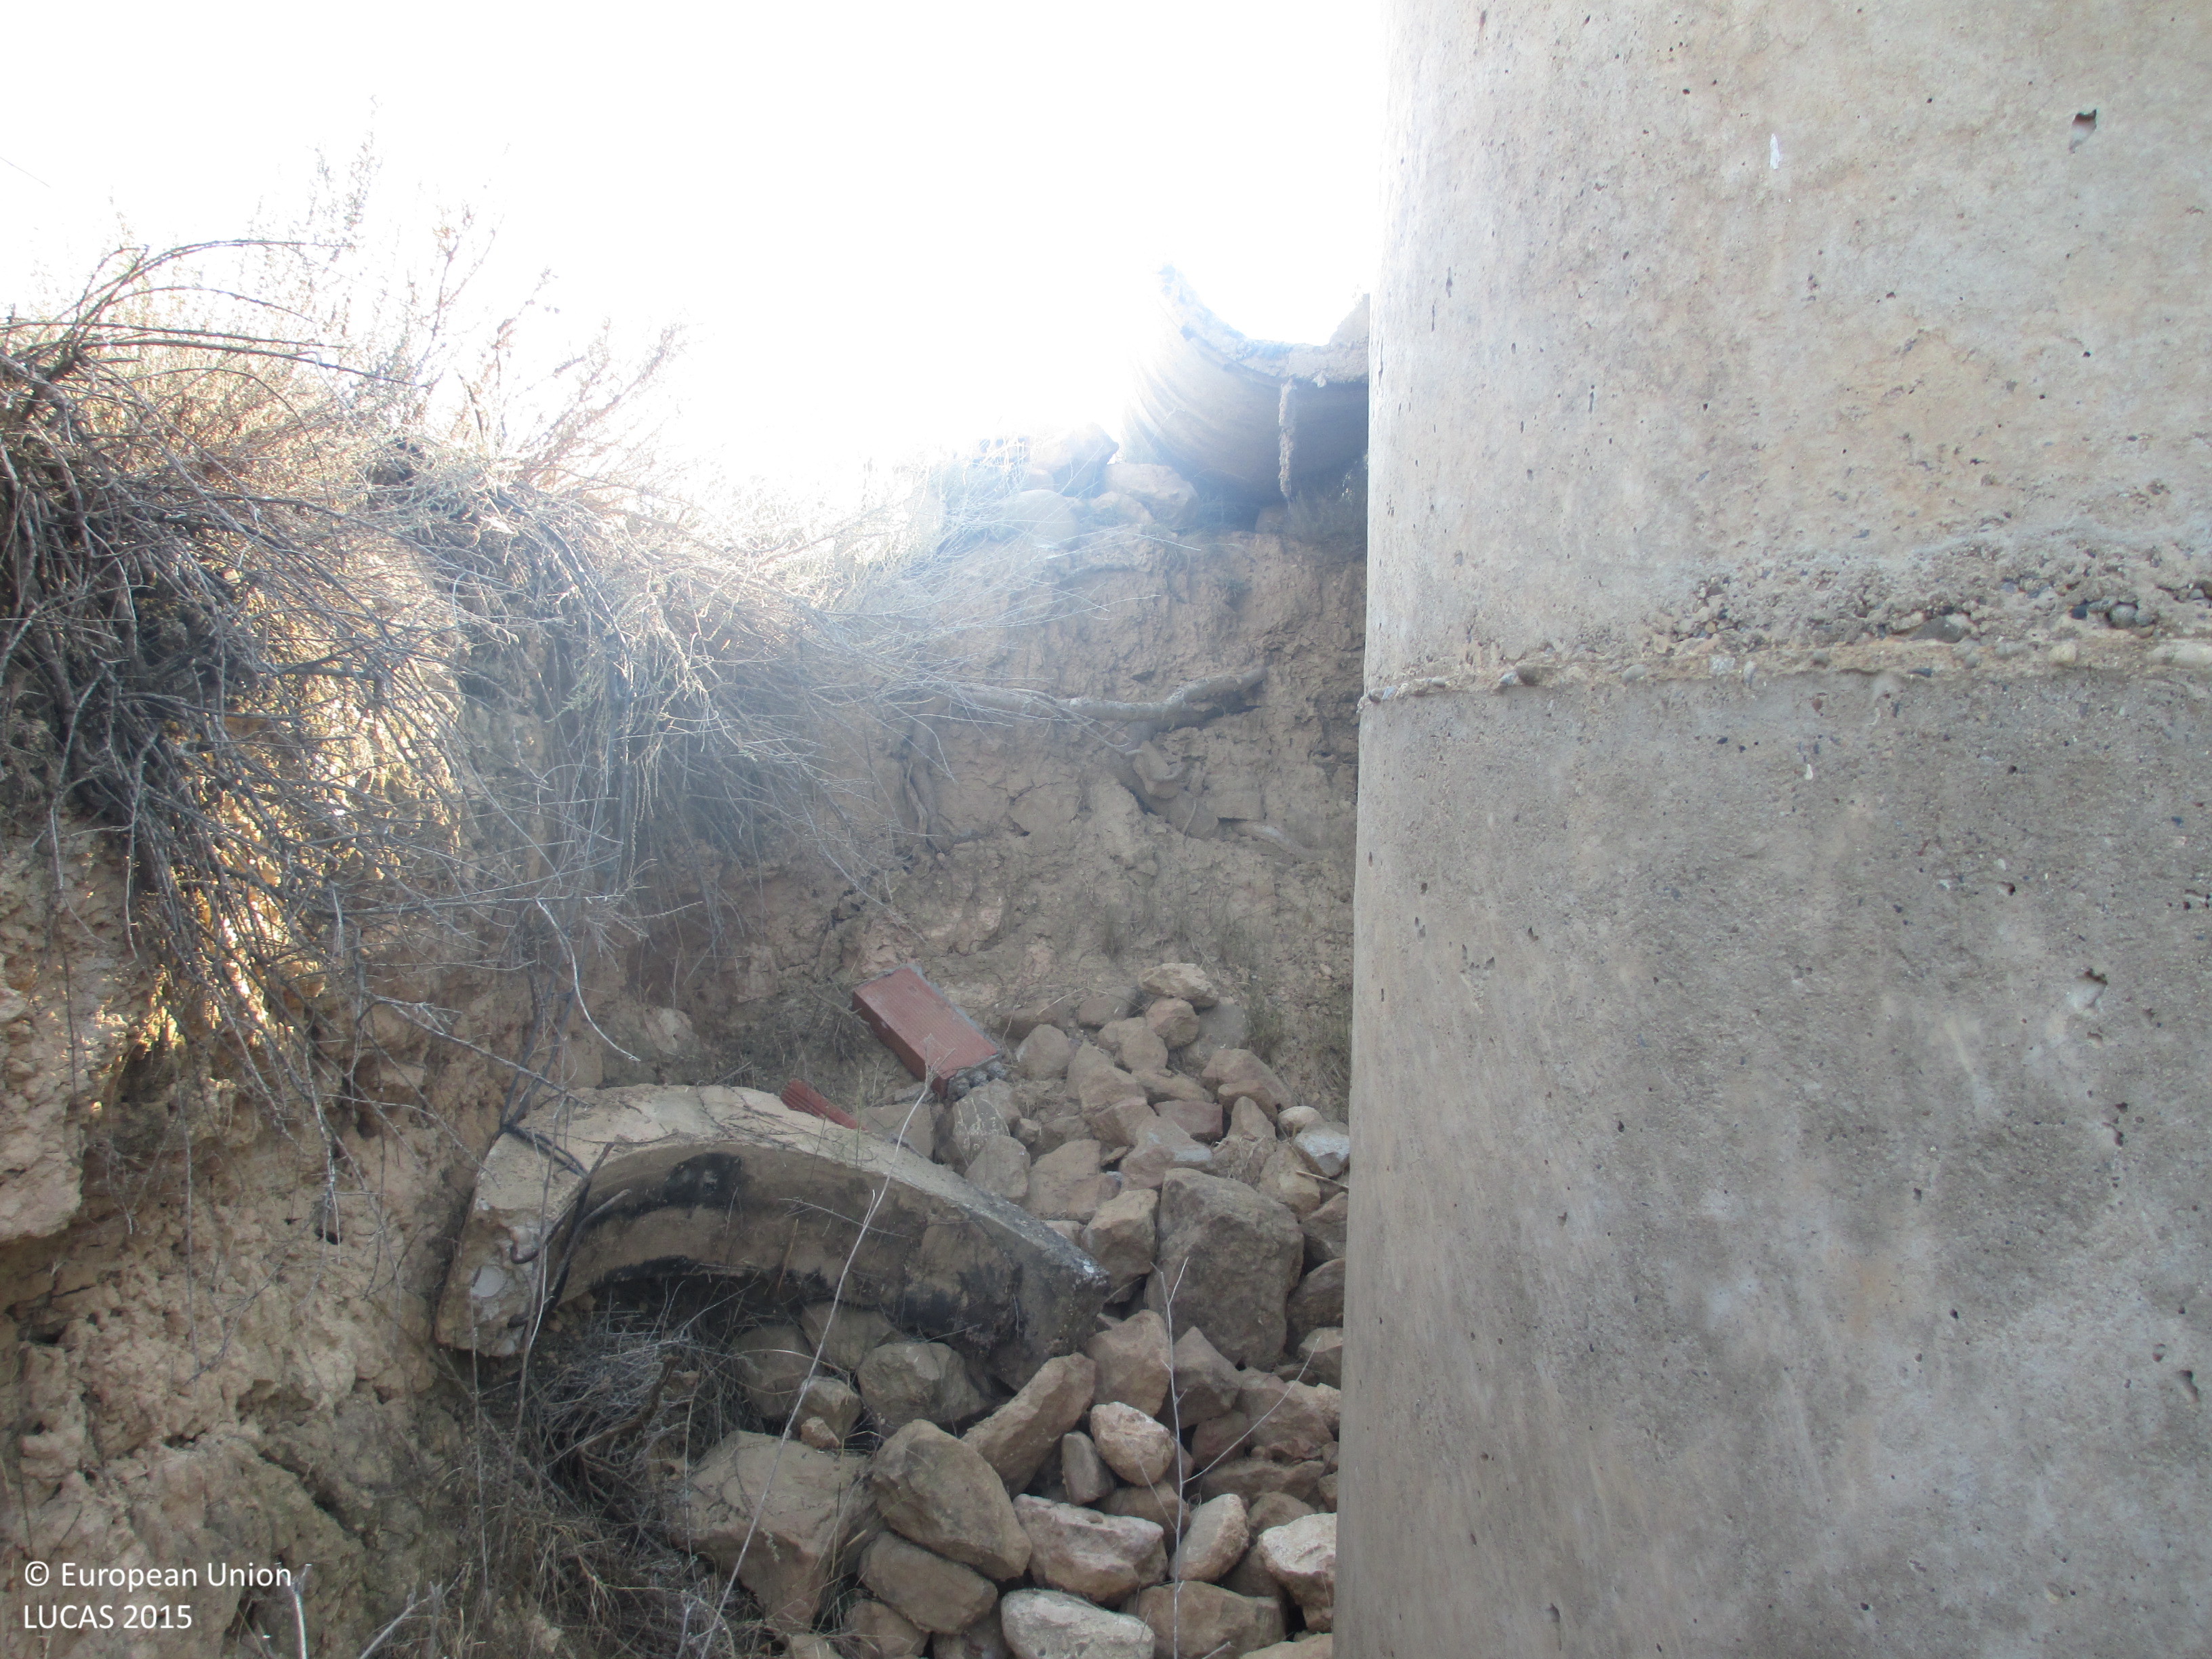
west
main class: Shrubland
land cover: Shrubland without tree cover
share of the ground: > 75 %
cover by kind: herbaceous plants 80 %, shrubs 20 %
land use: Semi-natural and natural areas not in use
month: July
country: ES
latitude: 41.8557
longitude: 0.0693
